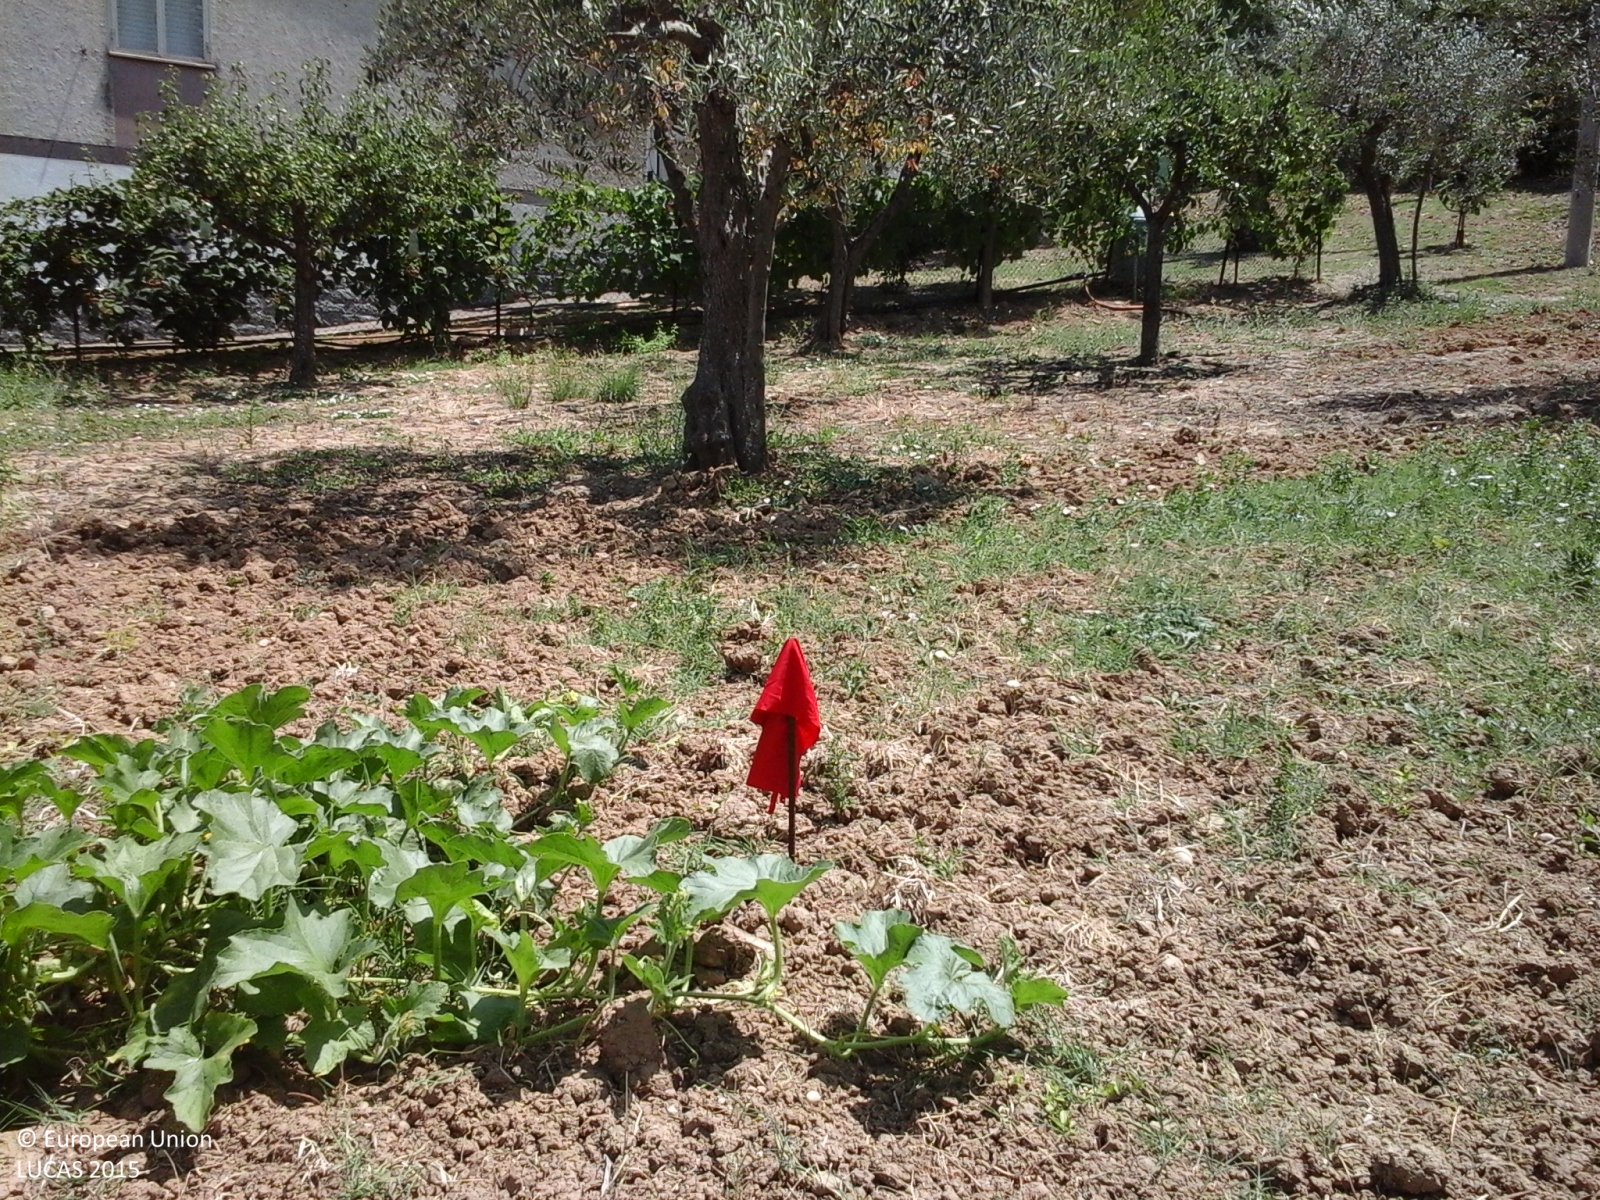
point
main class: Cropland
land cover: Olive groves
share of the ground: 25 - 50 %
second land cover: Other fresh vegetables
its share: 25 - 50 %
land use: Agriculture (excluding fallow land and kitchen gardens)
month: June
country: IT
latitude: 42.2345
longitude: 14.3610
